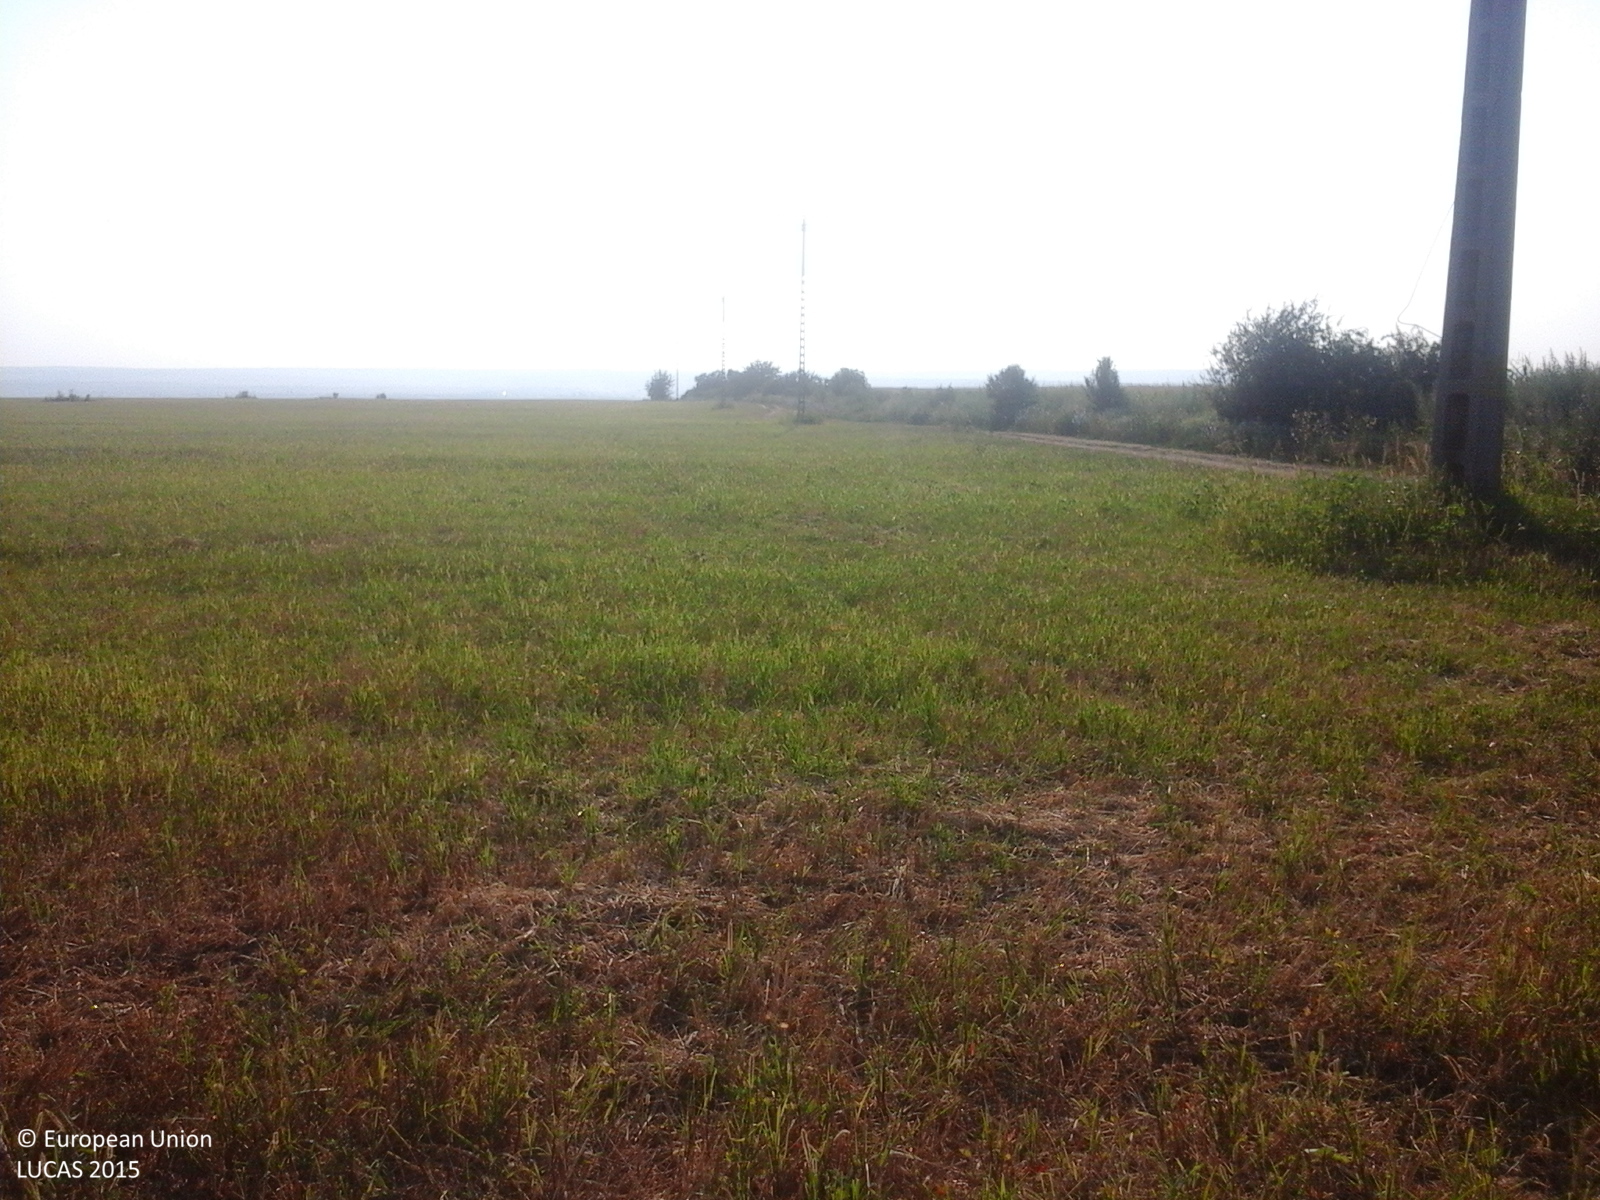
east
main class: Cropland
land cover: Durum wheat
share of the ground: > 75 %
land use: Agriculture (excluding fallow land and kitchen gardens)
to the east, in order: Durum wheat; Electric lines; Durum wheat; Tracks; Abandoned hedges; Spontaneously vegetated surfaces
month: July
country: RO
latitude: 45.9918
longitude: 28.0833
